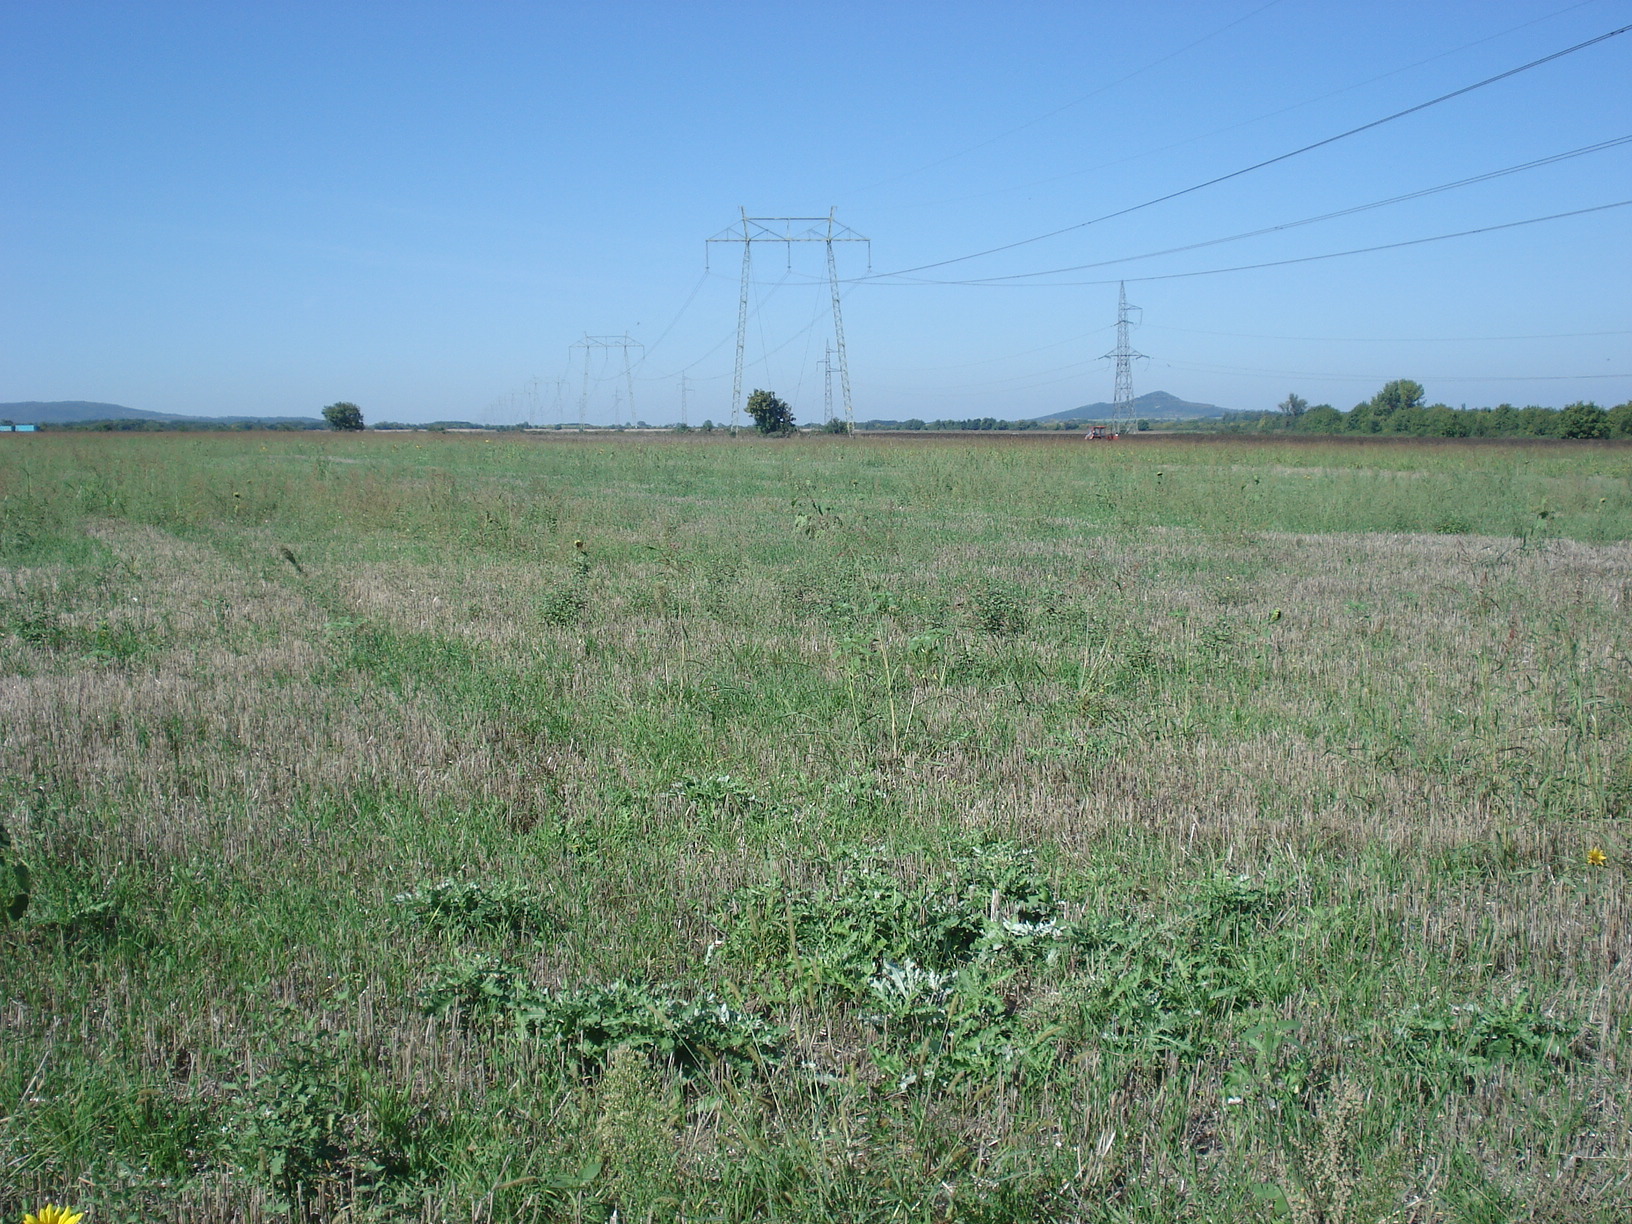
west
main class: Cropland
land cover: Common wheat
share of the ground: < 10 %
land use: Agriculture (excluding fallow land and kitchen gardens)
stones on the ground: < 10 %
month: October
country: BG
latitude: 43.2293
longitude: 25.2800
